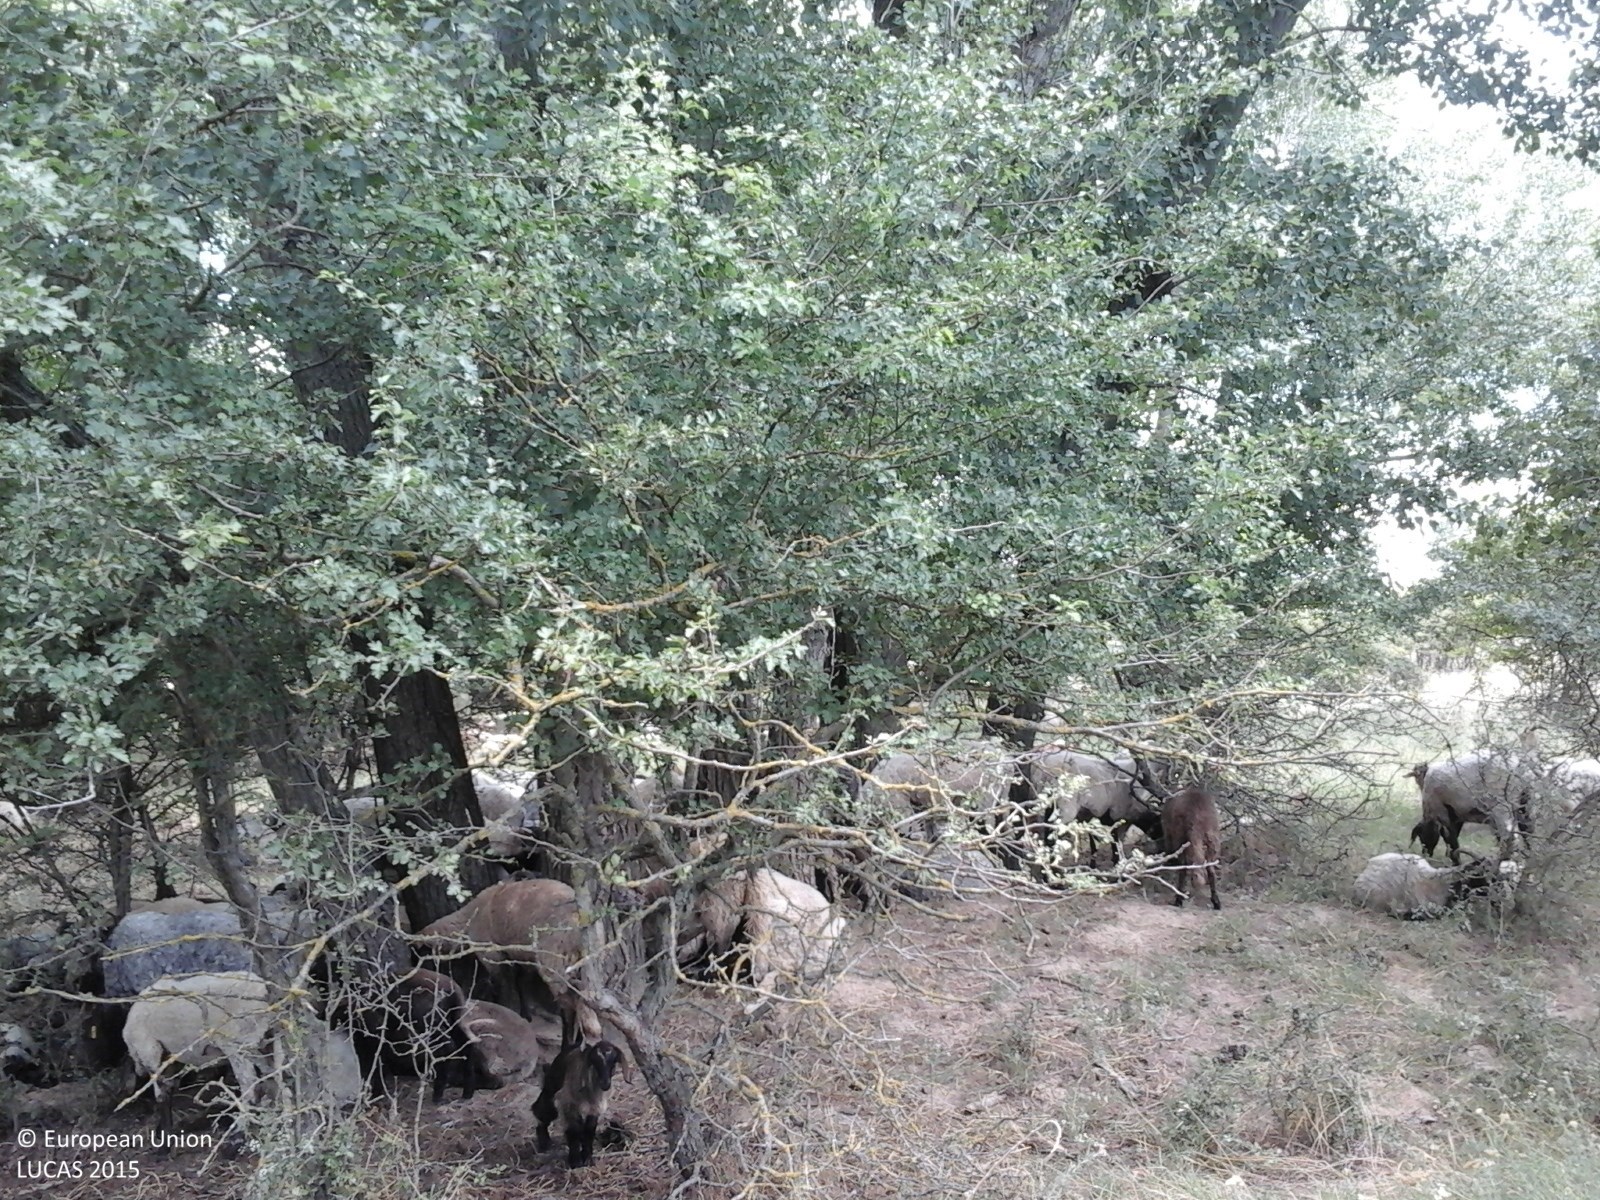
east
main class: Woodland
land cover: Broadleaved woodland
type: non-riverine alder, birch or aspen forest
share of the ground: 50 - 75 %
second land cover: Grassland without tree/shrub cover
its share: > 75 %
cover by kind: broadleaved forest trees 60 %, herbaceous plants 40 %
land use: Forestry
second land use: Agriculture (excluding fallow land and kitchen gardens)
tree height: > 5 m
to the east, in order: Broadleaved woodland; Grassland without tree/shrub cover; Grassland with sparse tree/shrub cover; Tracks; Grassland without tree/shrub cover; Inland fresh running water; Grass margins; Tracks; Grassland without tree/shrub cover; Tracks; Inland fresh running water
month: July
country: RO
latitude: 43.9719
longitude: 24.5896
